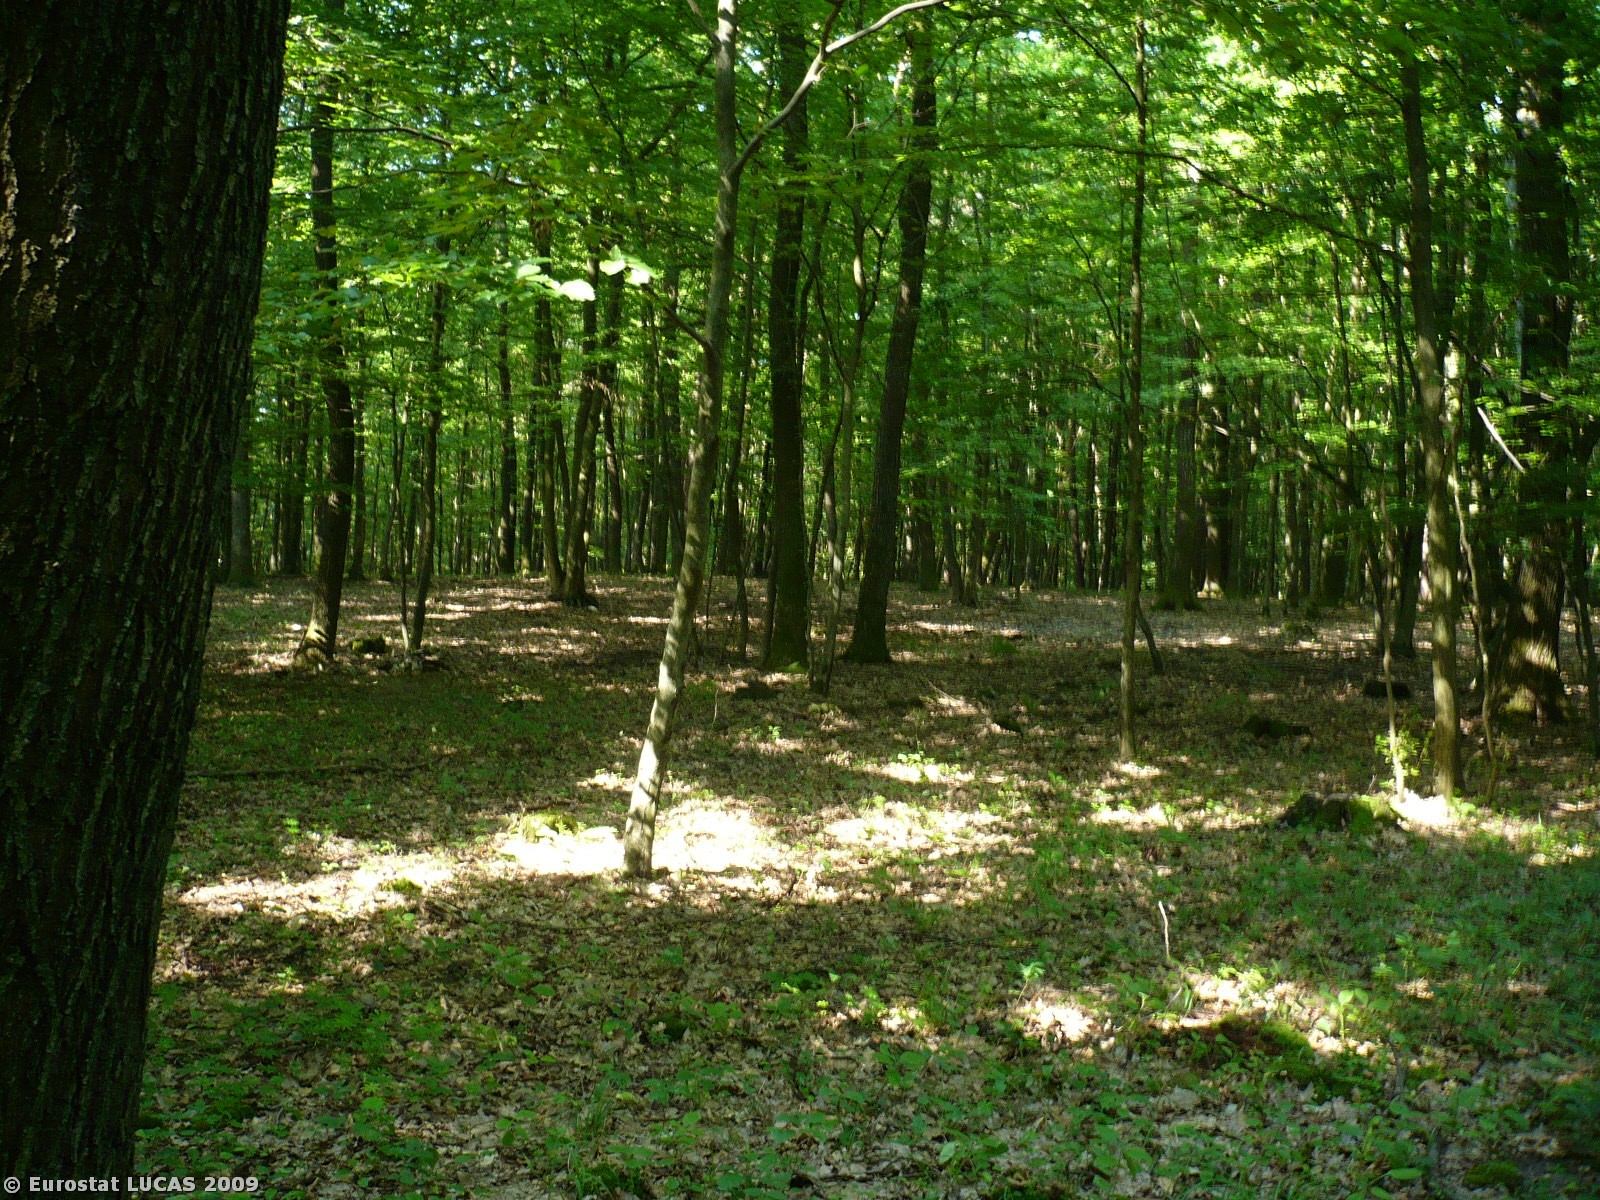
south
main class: Woodland
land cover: Broadleaved woodland
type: mesophytic deciduous forest
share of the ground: > 75 %
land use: Forestry
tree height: > 5 m
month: July
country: SI
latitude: 46.6852
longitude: 16.3686
